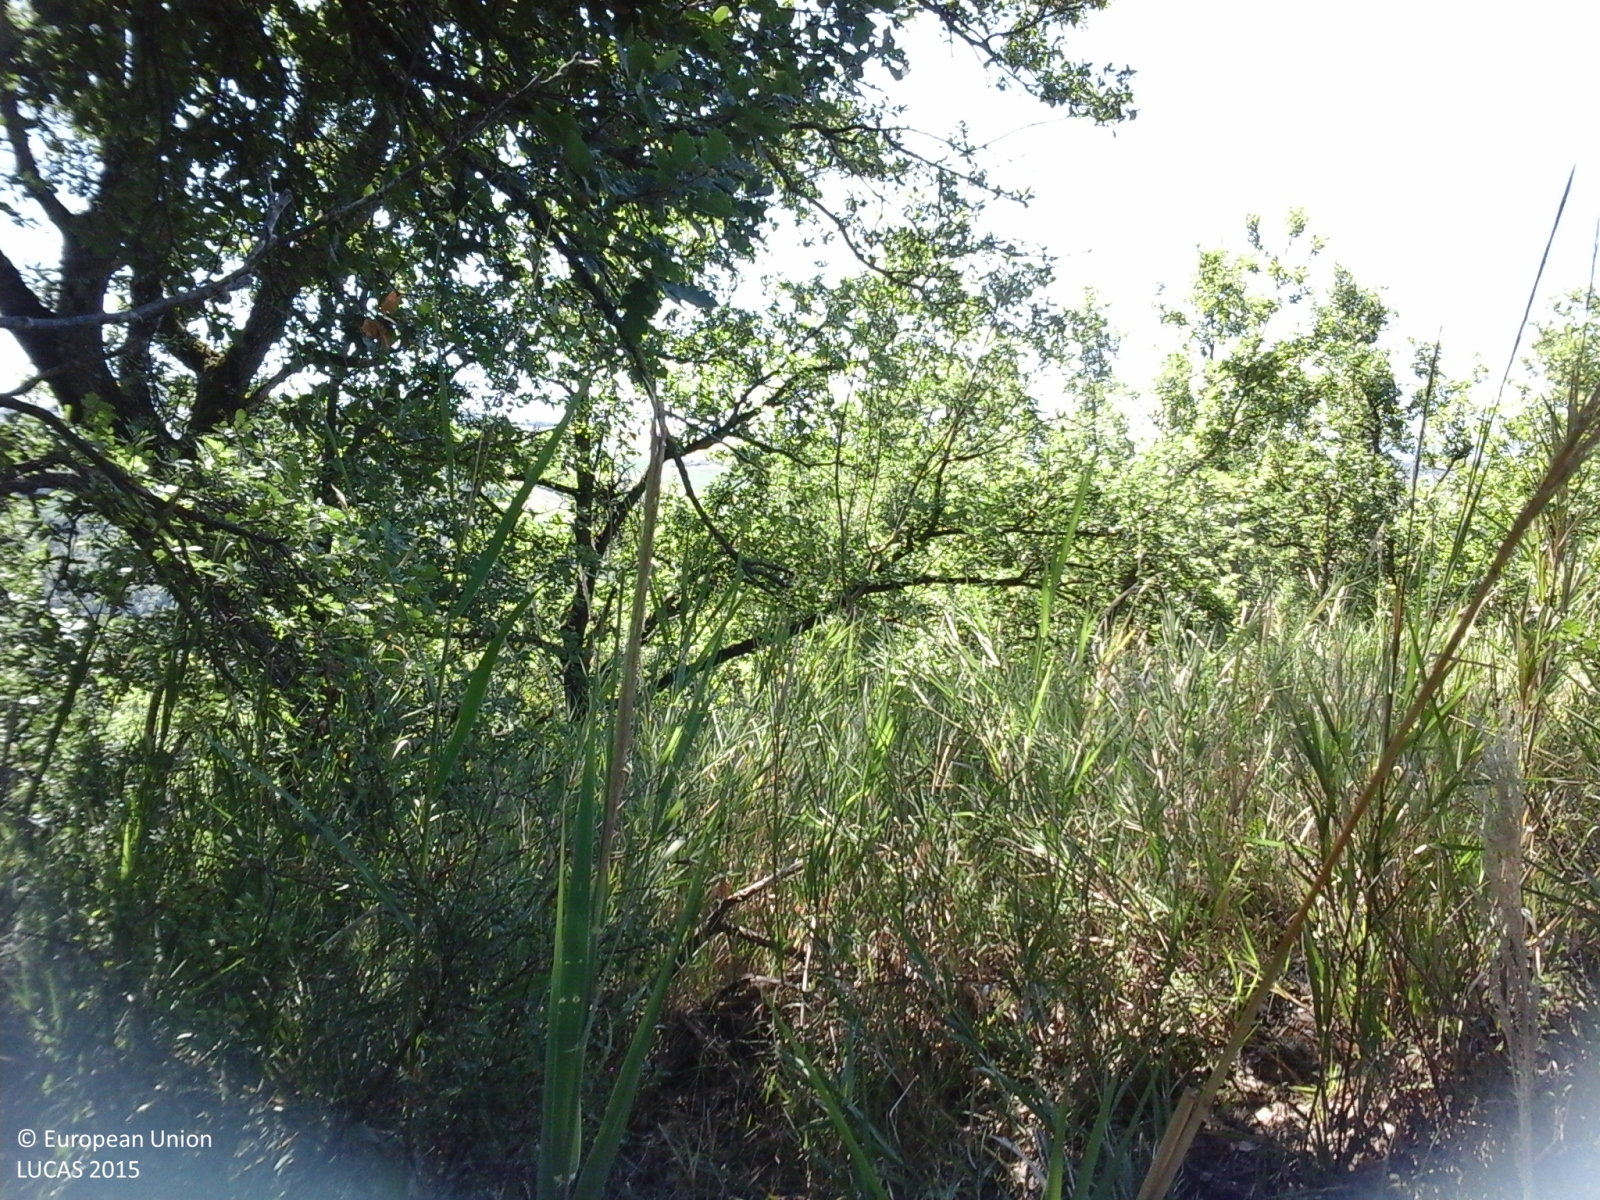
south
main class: Woodland
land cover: Broadleaved woodland
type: thermophilous deciduous forest
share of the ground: > 75 %
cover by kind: broadleaved forest trees 100 %
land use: Forestry
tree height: > 5 m
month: August
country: IT
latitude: 43.0499
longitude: 13.3668
